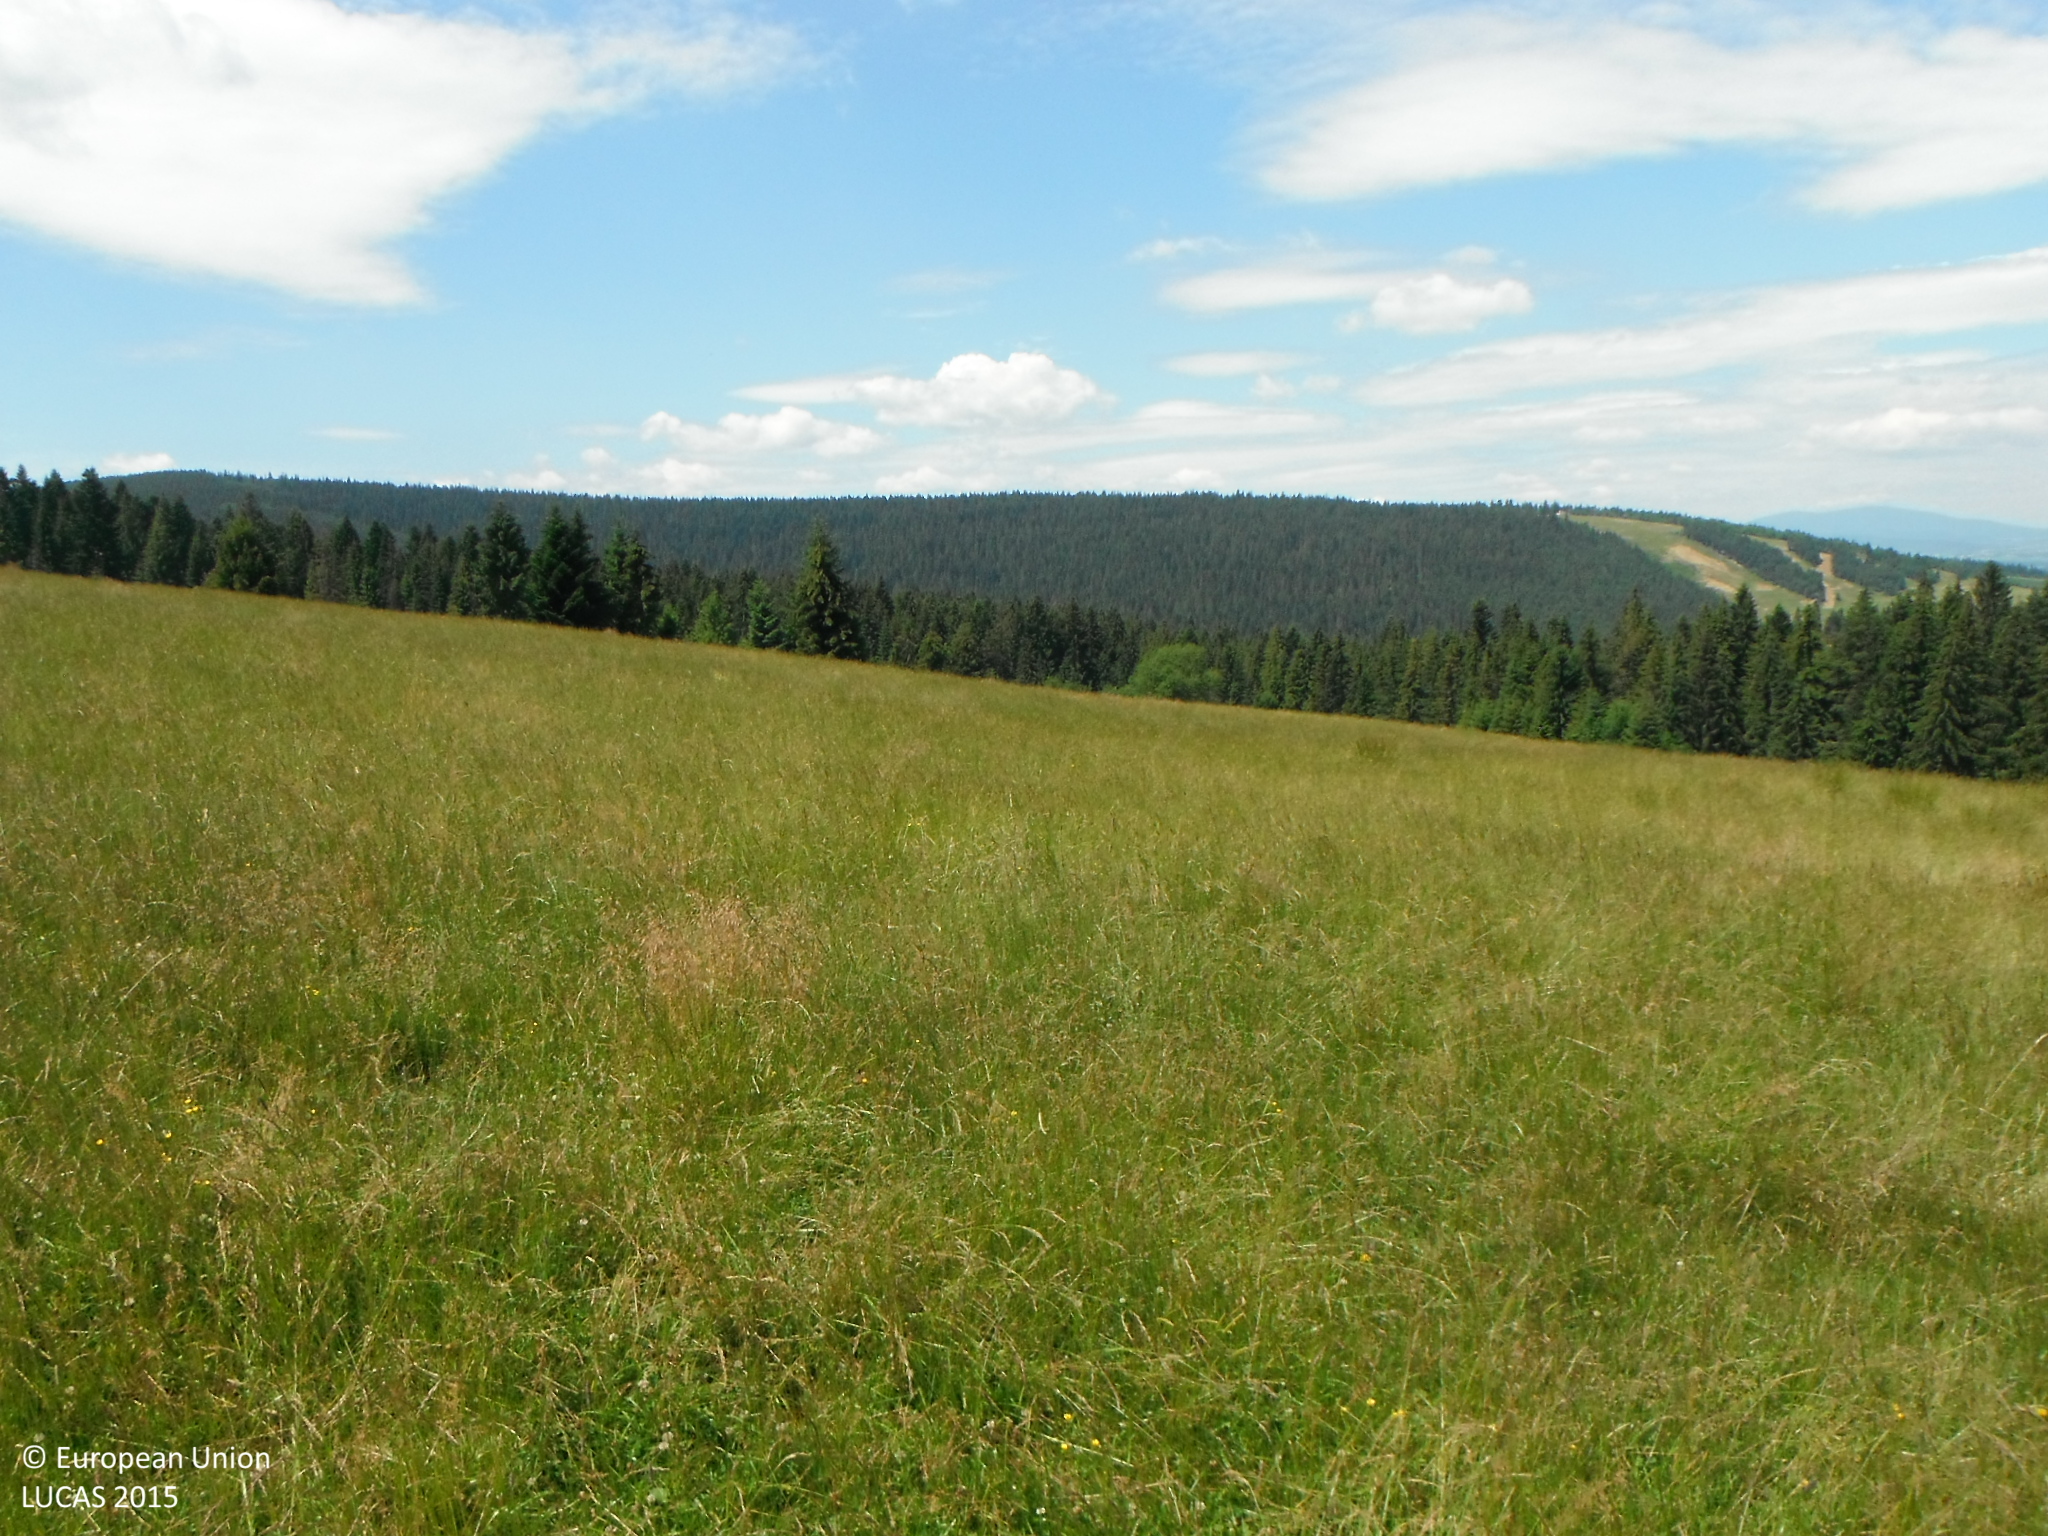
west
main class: Grassland
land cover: Grassland without tree/shrub cover
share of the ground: > 75 %
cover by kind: herbaceous plants 100 %
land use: Agriculture (excluding fallow land and kitchen gardens)
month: July
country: SK
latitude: 49.3300
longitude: 19.7573
